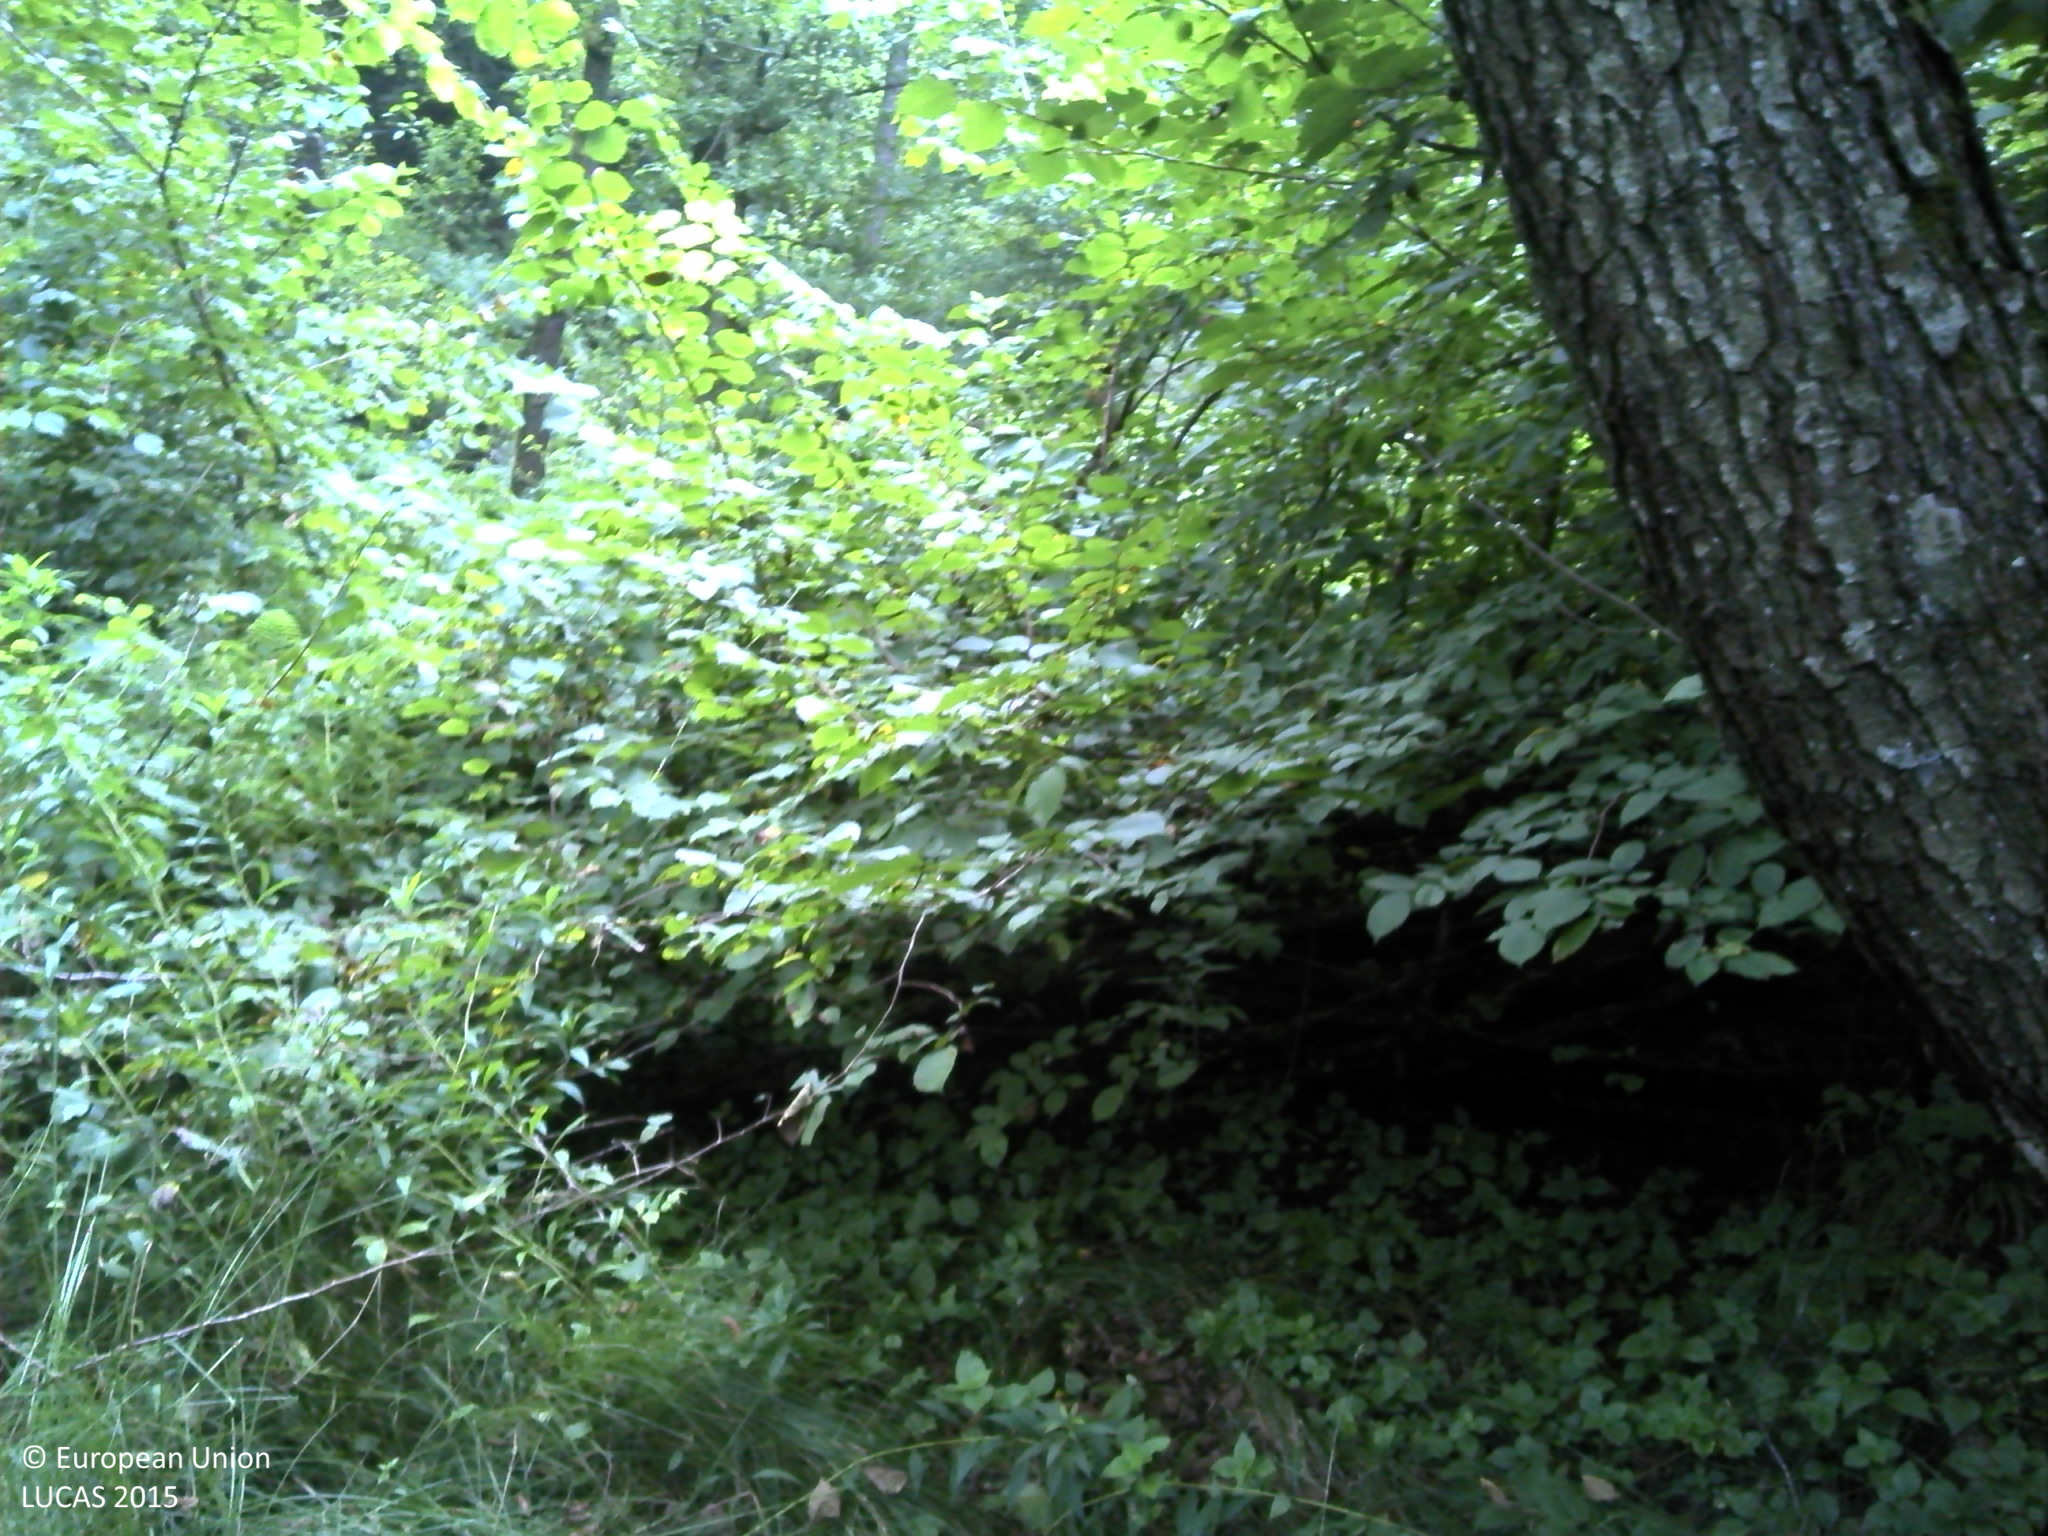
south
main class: Woodland
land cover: Broadleaved woodland
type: acidophilous oak and oak-birch forest
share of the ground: > 75 %
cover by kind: broadleaved forest trees 100 %
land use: Forestry
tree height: > 5 m
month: August
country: HR
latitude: 45.3212
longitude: 15.9030
